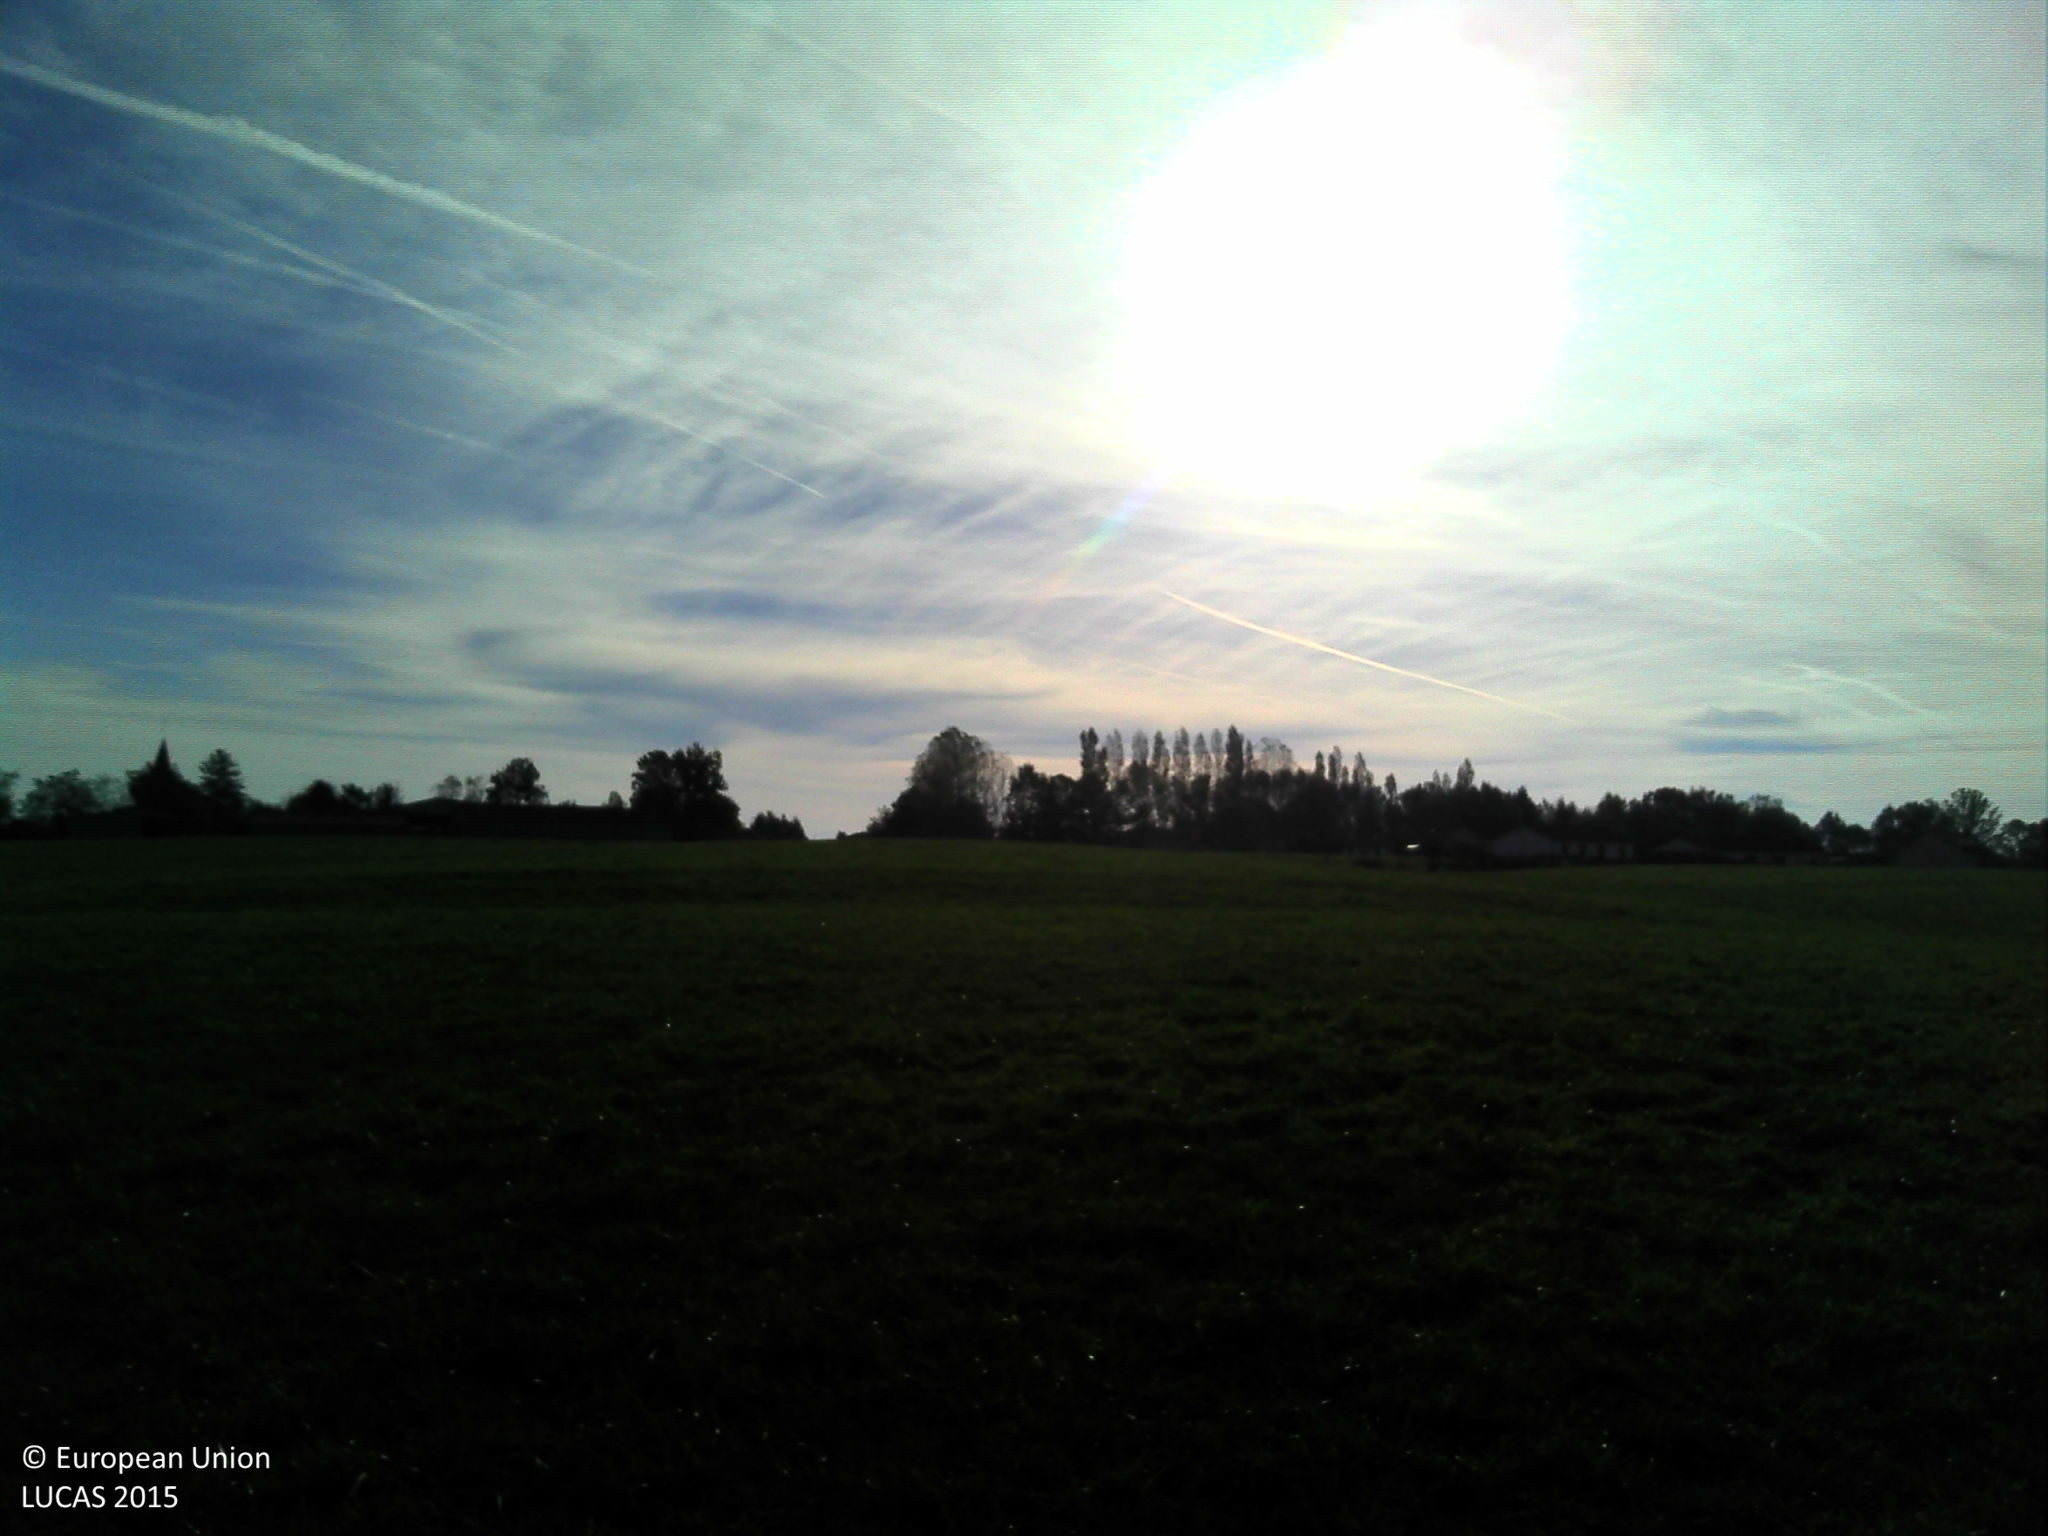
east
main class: Grassland
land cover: Grassland without tree/shrub cover
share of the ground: > 75 %
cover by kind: herbaceous plants 100 %
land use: Agriculture (excluding fallow land and kitchen gardens)
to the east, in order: Grassland without tree/shrub cover; Fences; Grassland without tree/shrub cover; Artificial constructions in urban areas
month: October
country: FR
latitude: 46.4145
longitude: 4.9935
